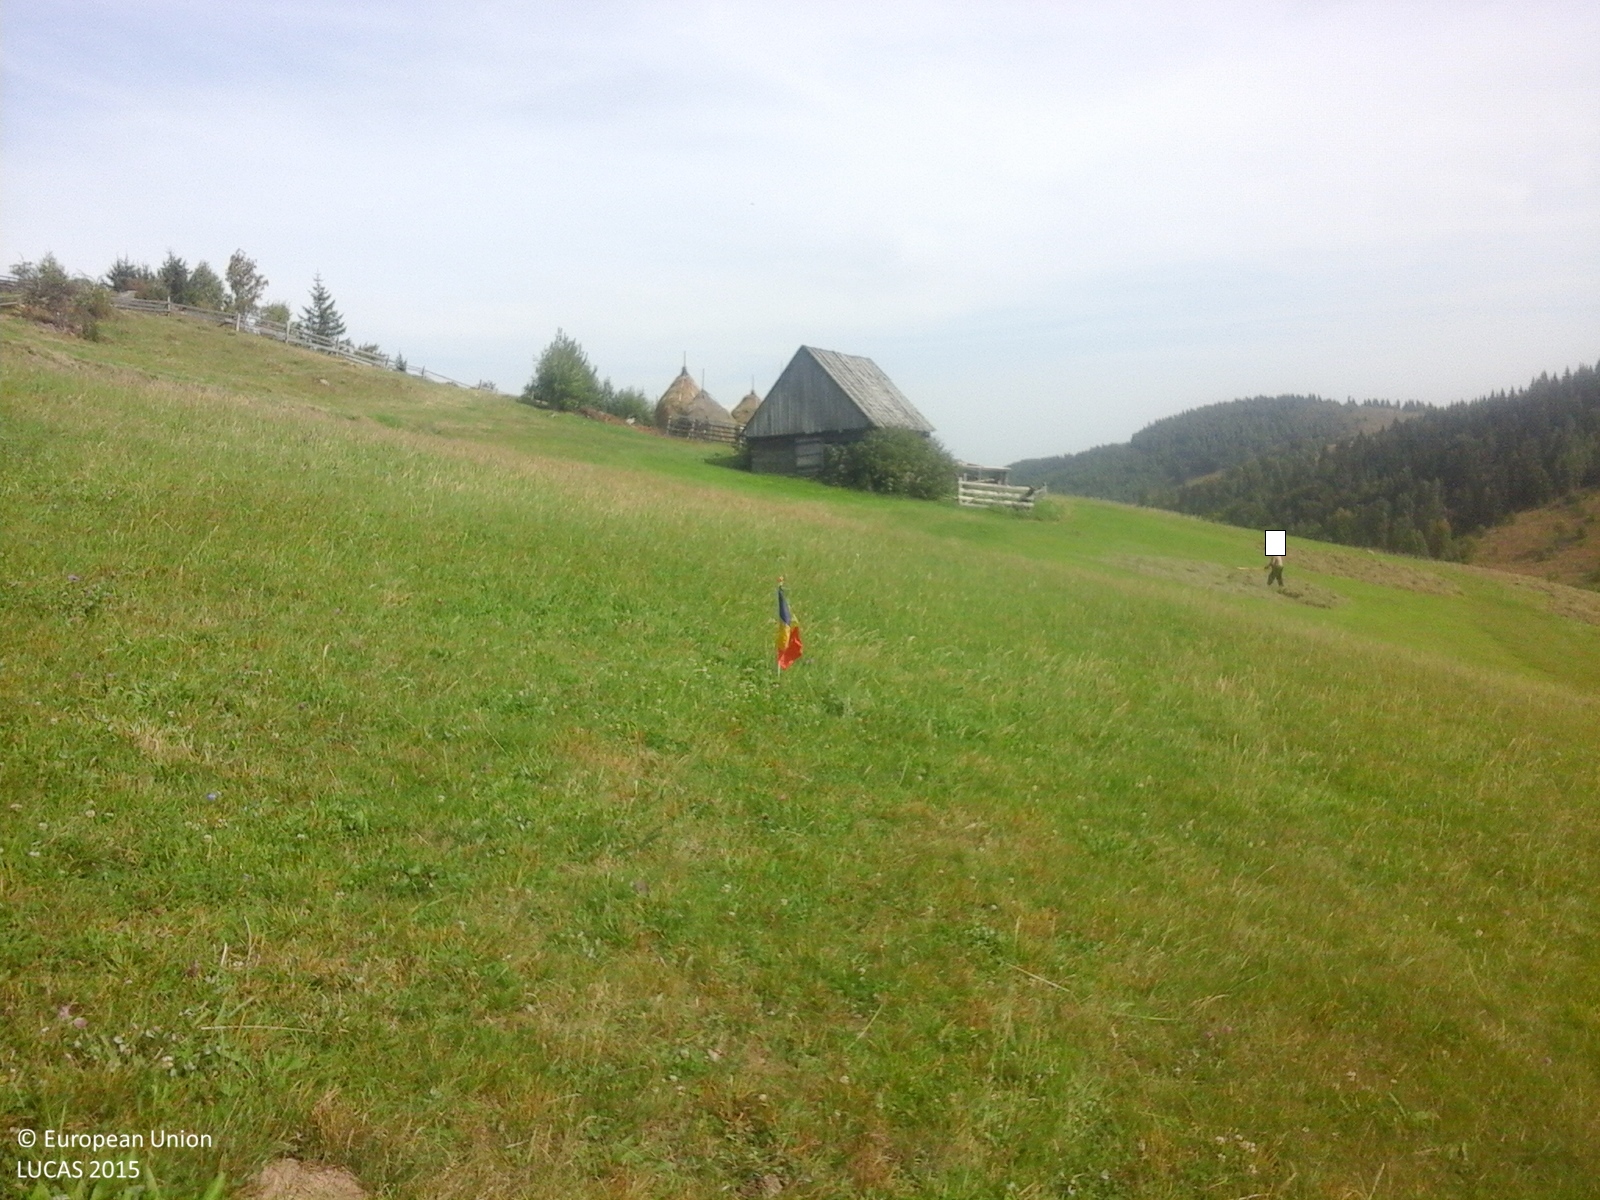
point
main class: Grassland
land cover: Grassland without tree/shrub cover
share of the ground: > 75 %
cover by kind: herbaceous plants 100 %
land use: Agriculture (excluding fallow land and kitchen gardens)
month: September
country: RO
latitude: 46.6328
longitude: 23.2703
